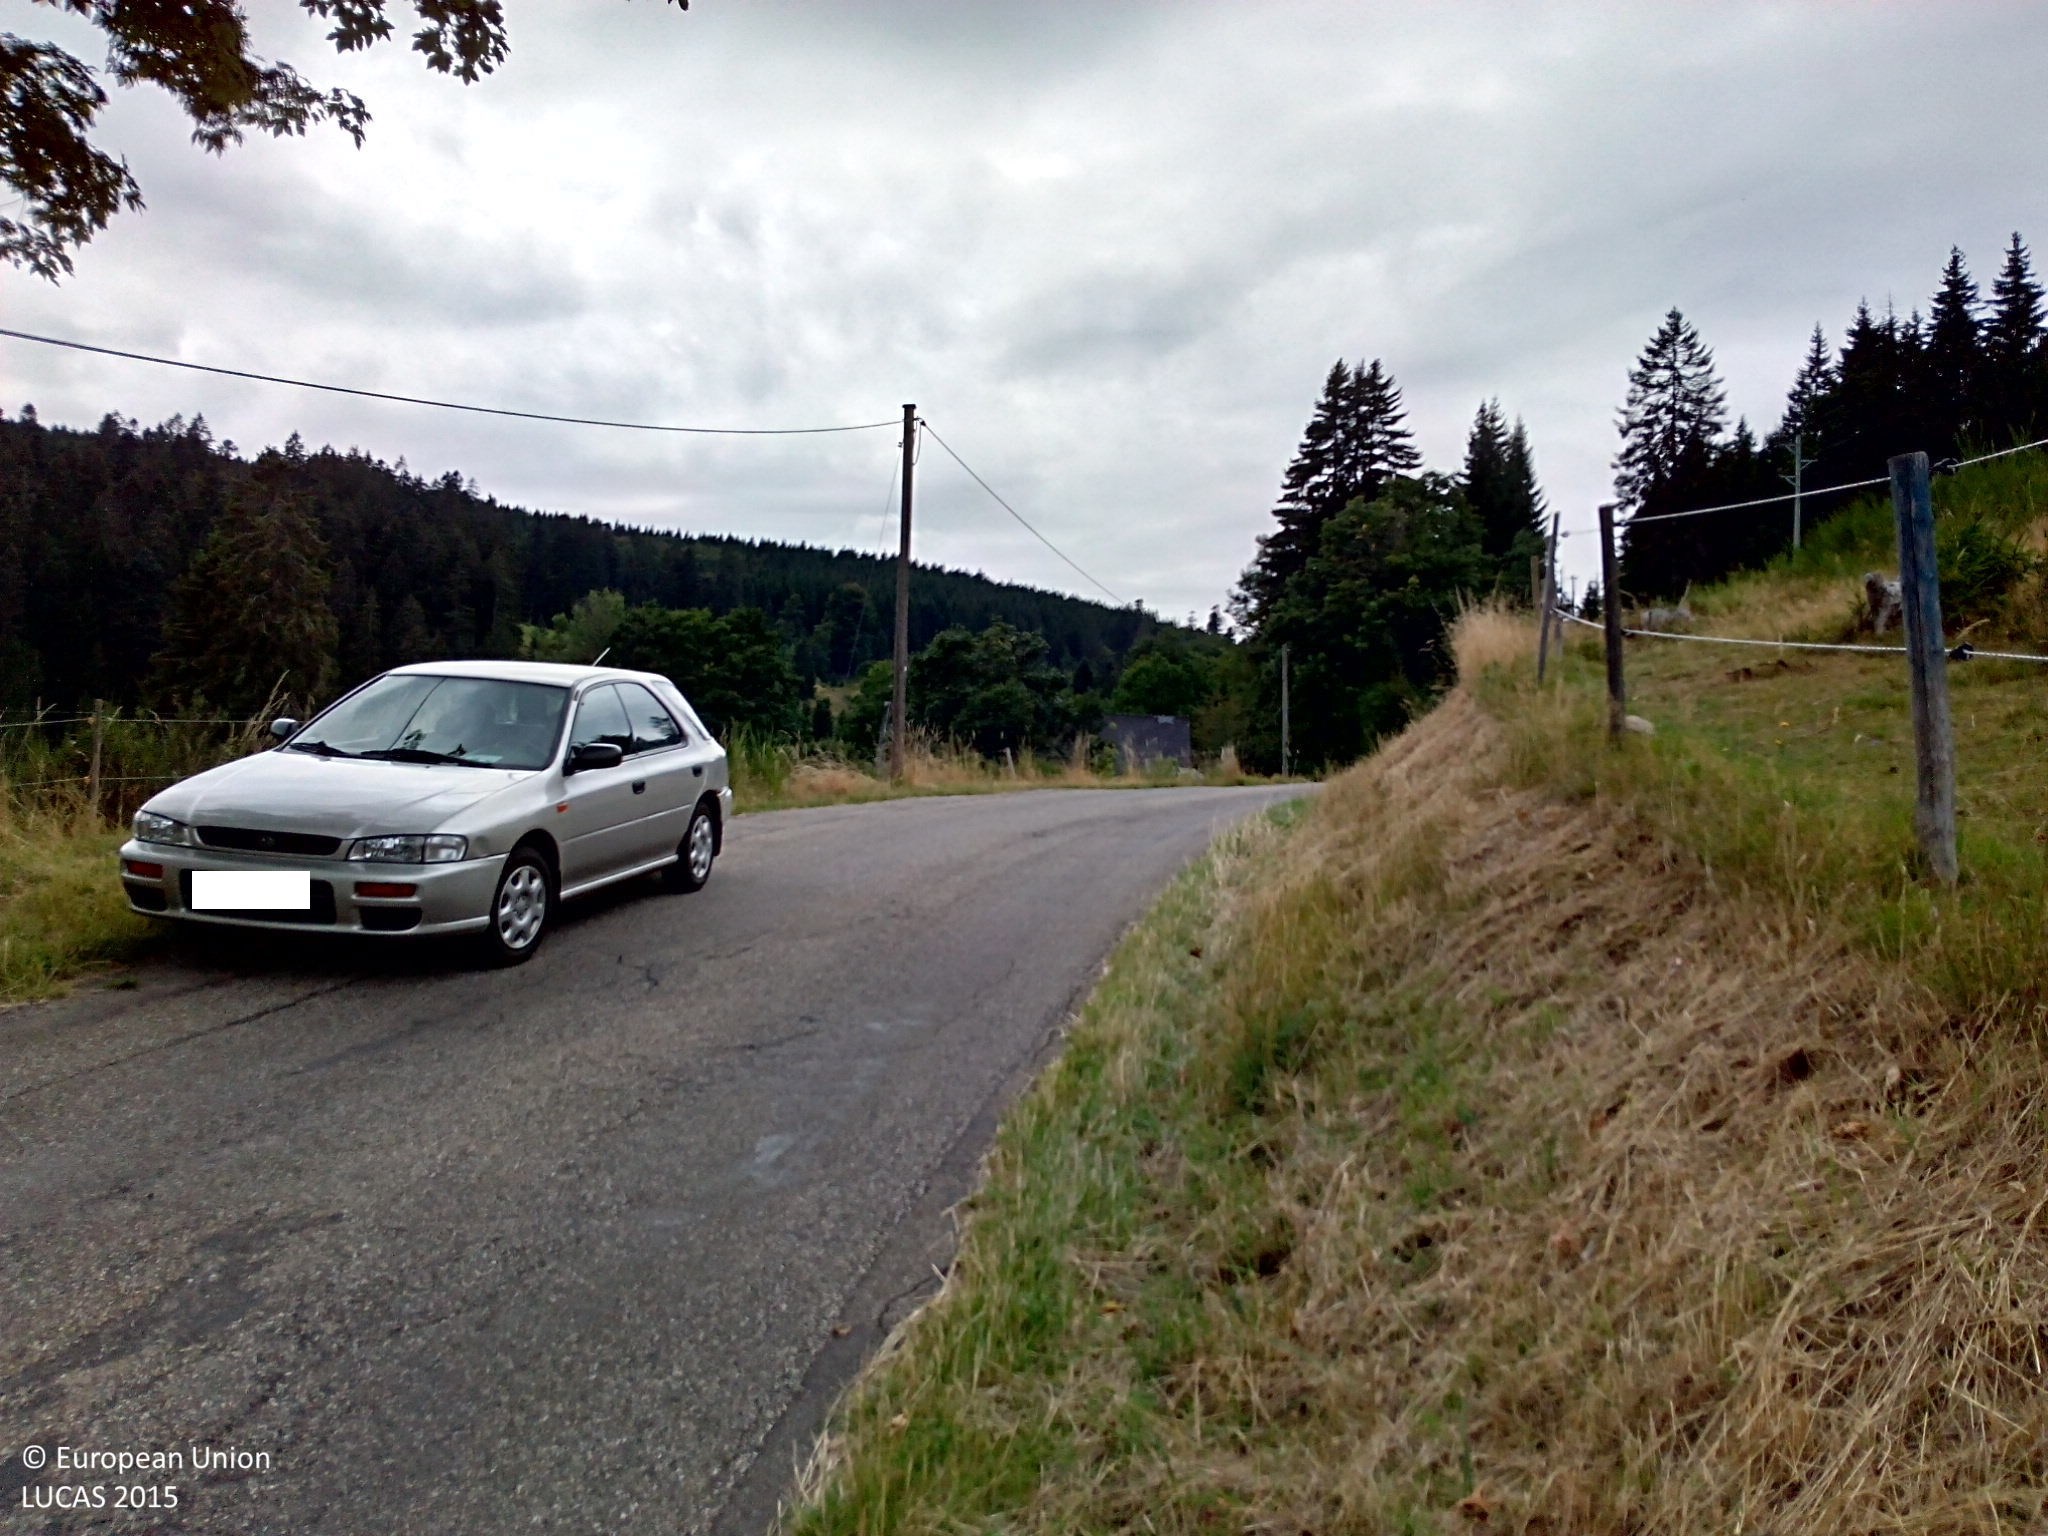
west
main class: Shrubland
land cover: Shrubland without tree cover
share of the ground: 25 - 50 %
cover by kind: herbaceous plants 75 %, shrubs 25 %
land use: Agriculture (excluding fallow land and kitchen gardens)
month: August
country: DE
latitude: 47.7939
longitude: 8.1456
